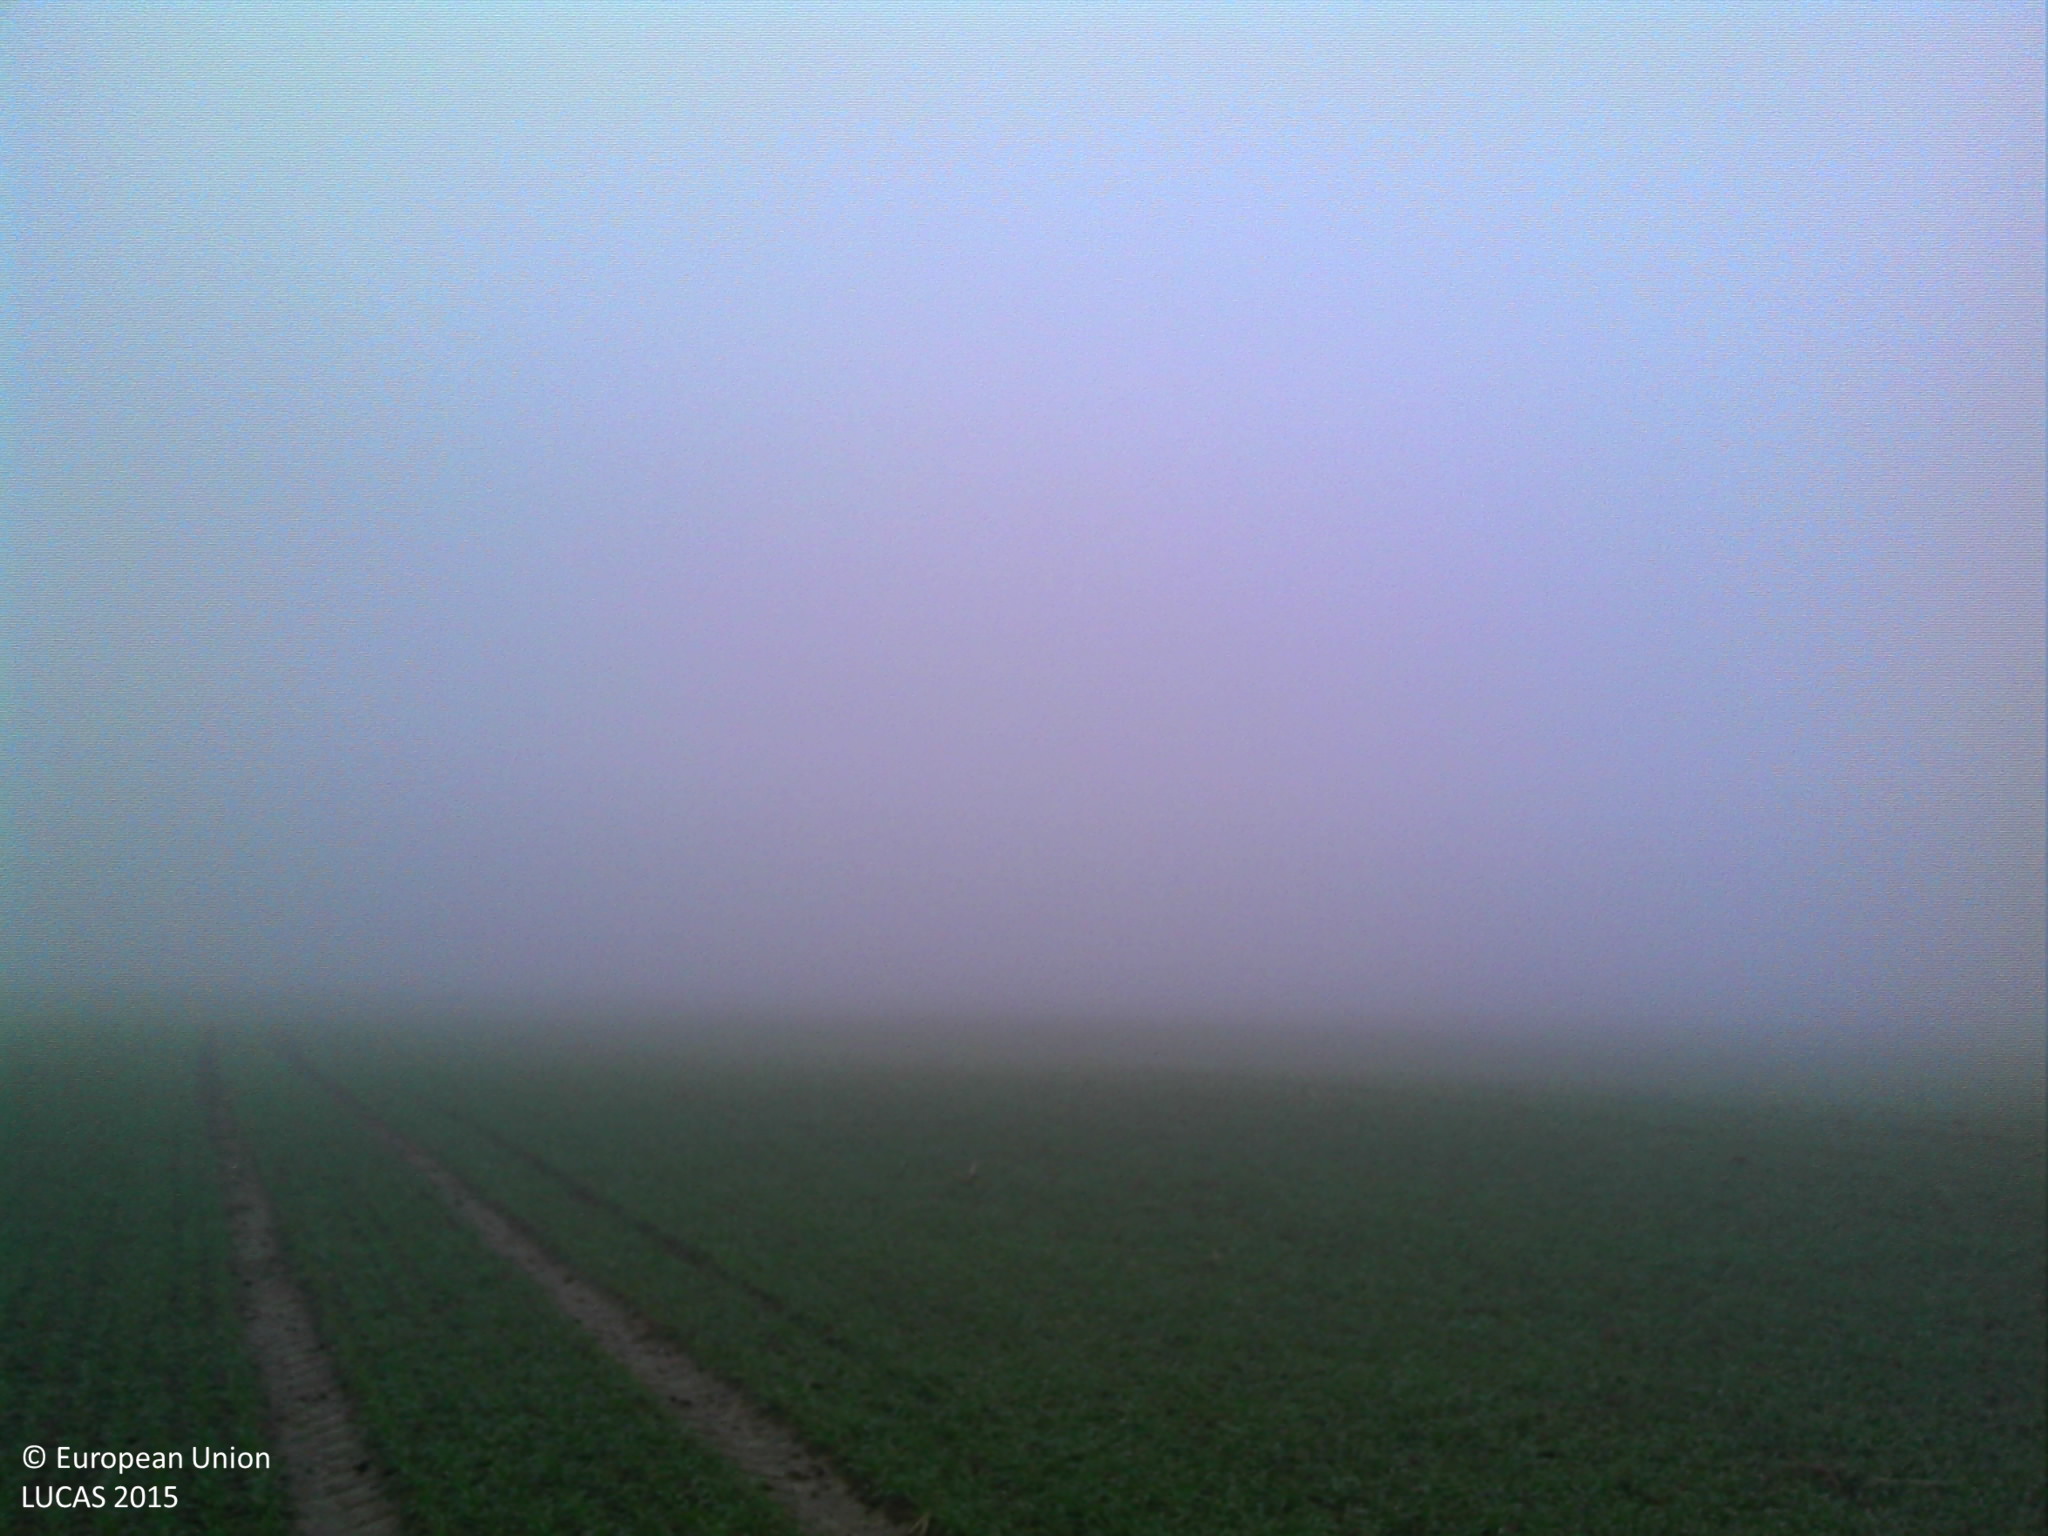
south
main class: Cropland
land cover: Common wheat
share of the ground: > 75 %
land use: Agriculture (excluding fallow land and kitchen gardens)
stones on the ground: < 10 %
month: December
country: FR
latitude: 46.2396
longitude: 5.1137
